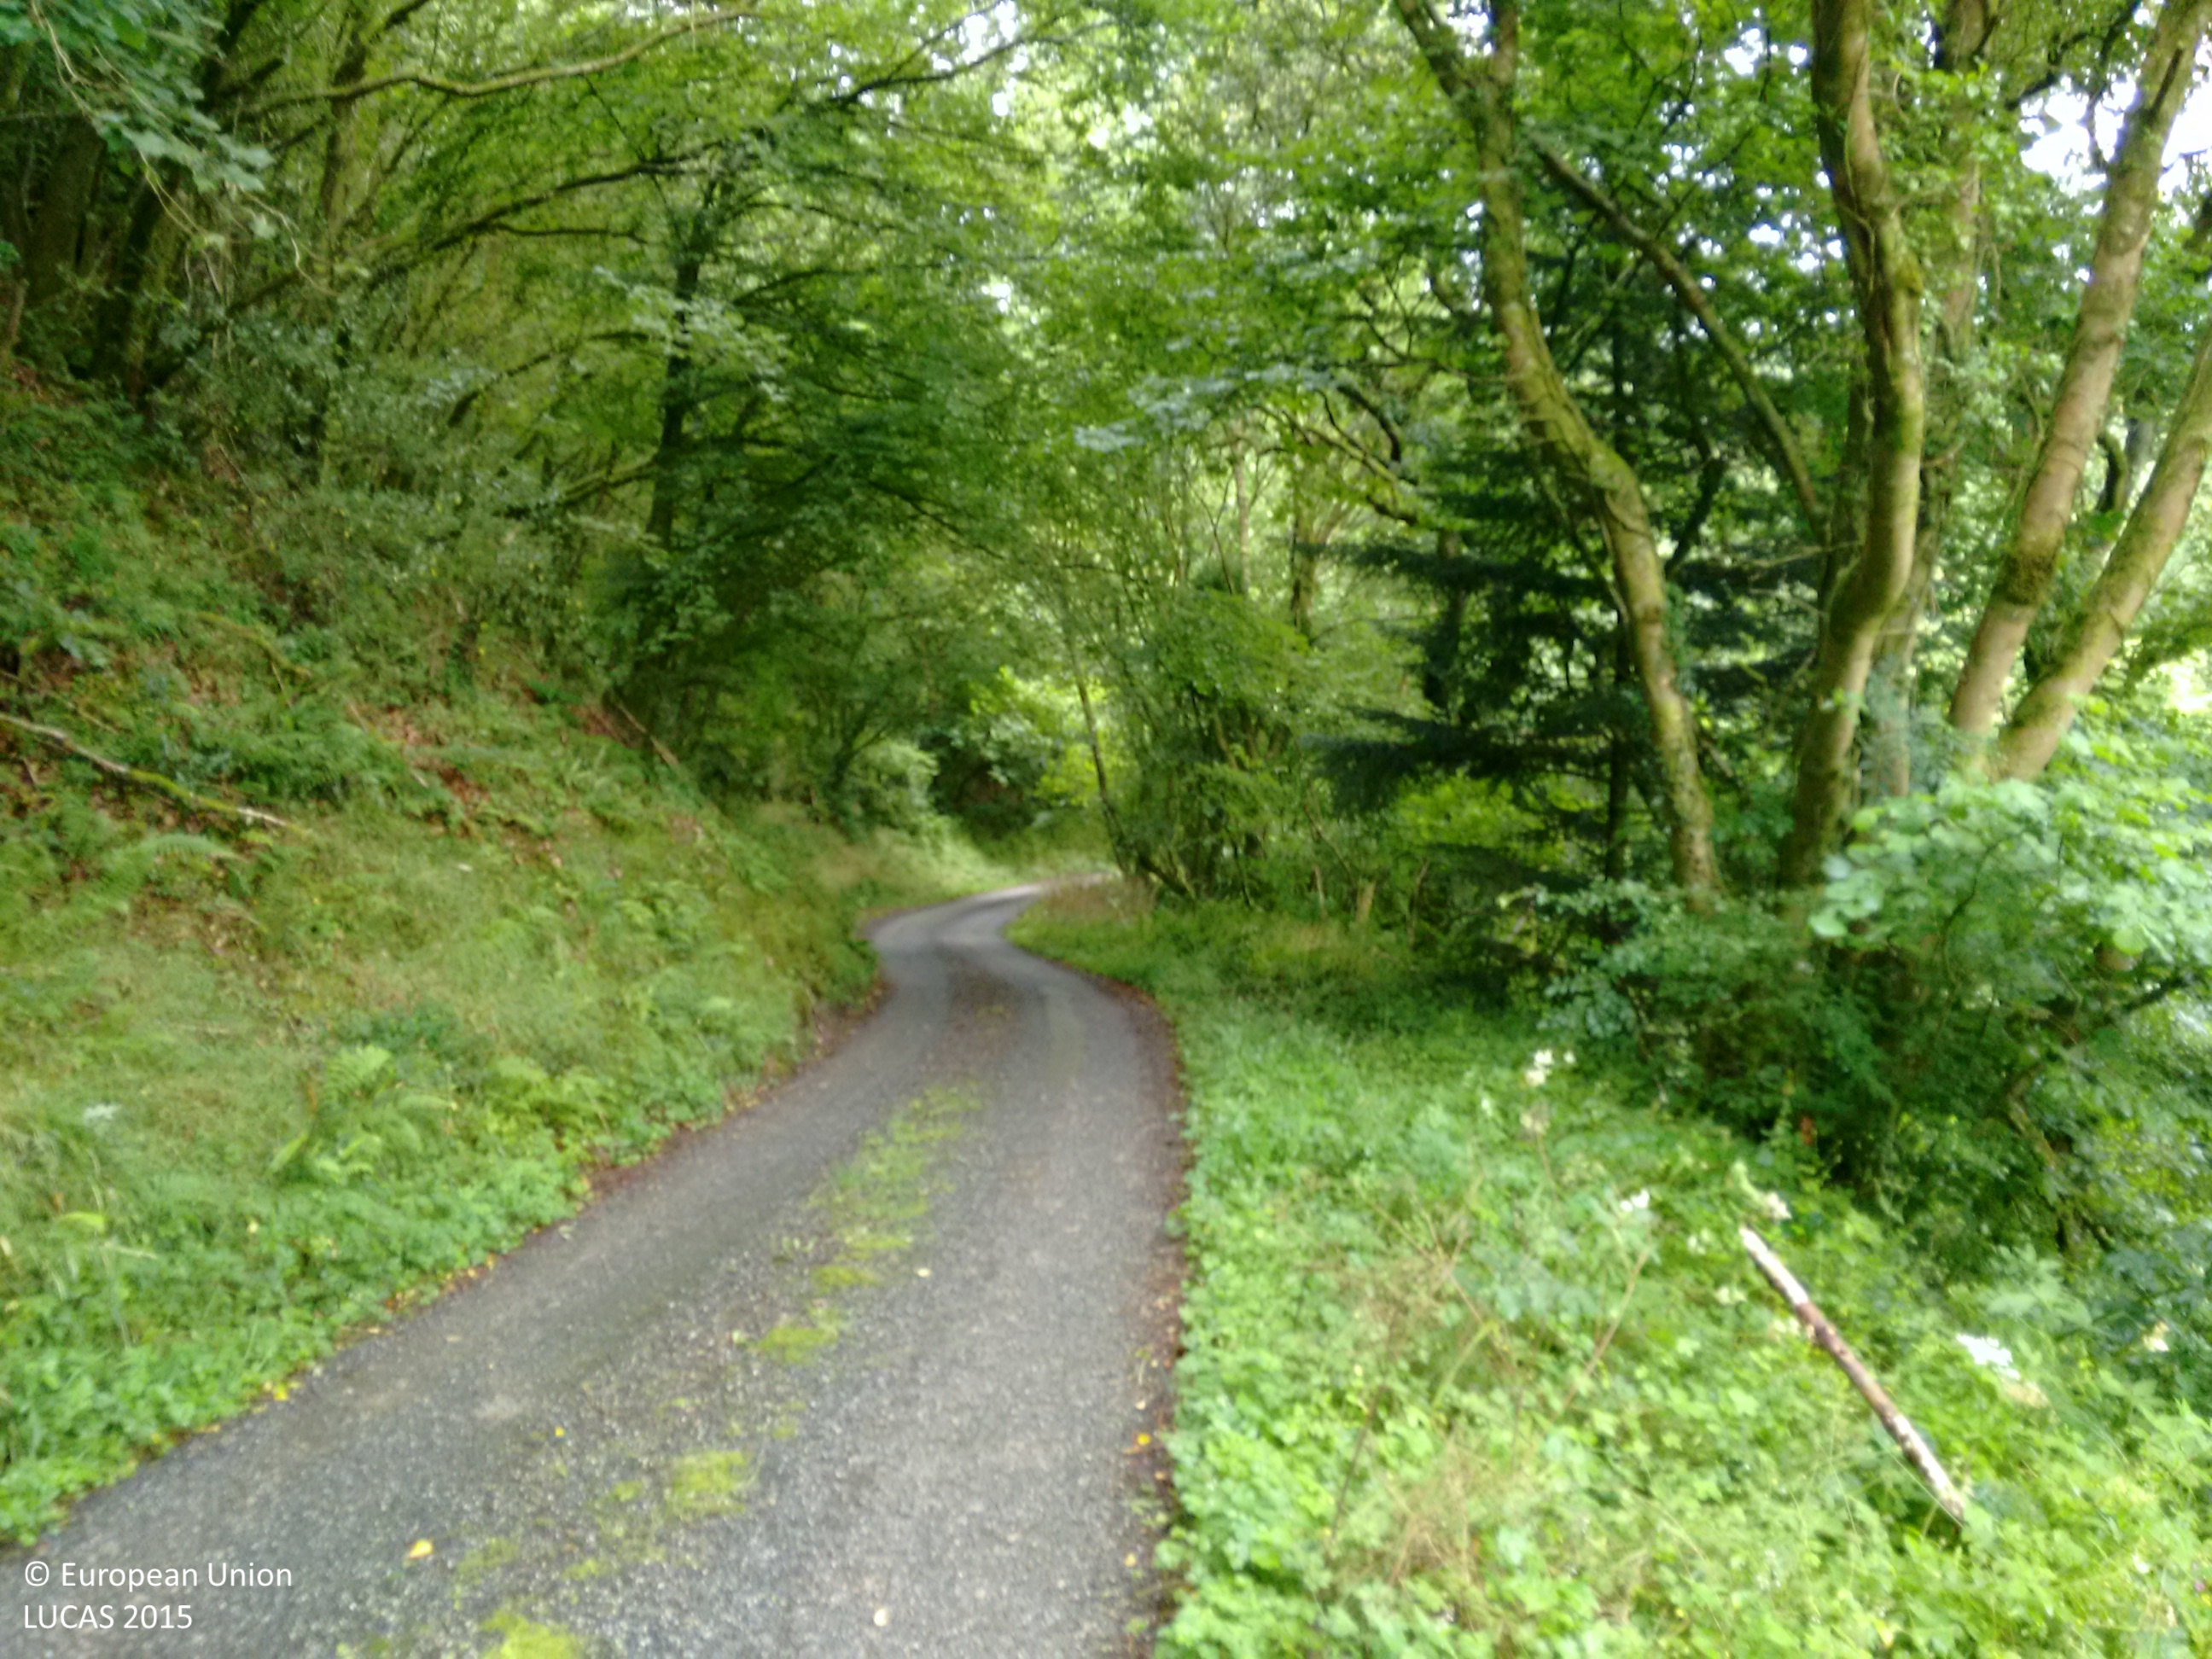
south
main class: Woodland
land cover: Spruce dominated coniferous woodland
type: exotic forest
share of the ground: > 75 %
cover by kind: coniferous forest trees 90 %, shrubs 10 %
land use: Semi-natural and natural areas not in use
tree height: > 5 m
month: August
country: GB
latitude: 51.9001
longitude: -4.5083
